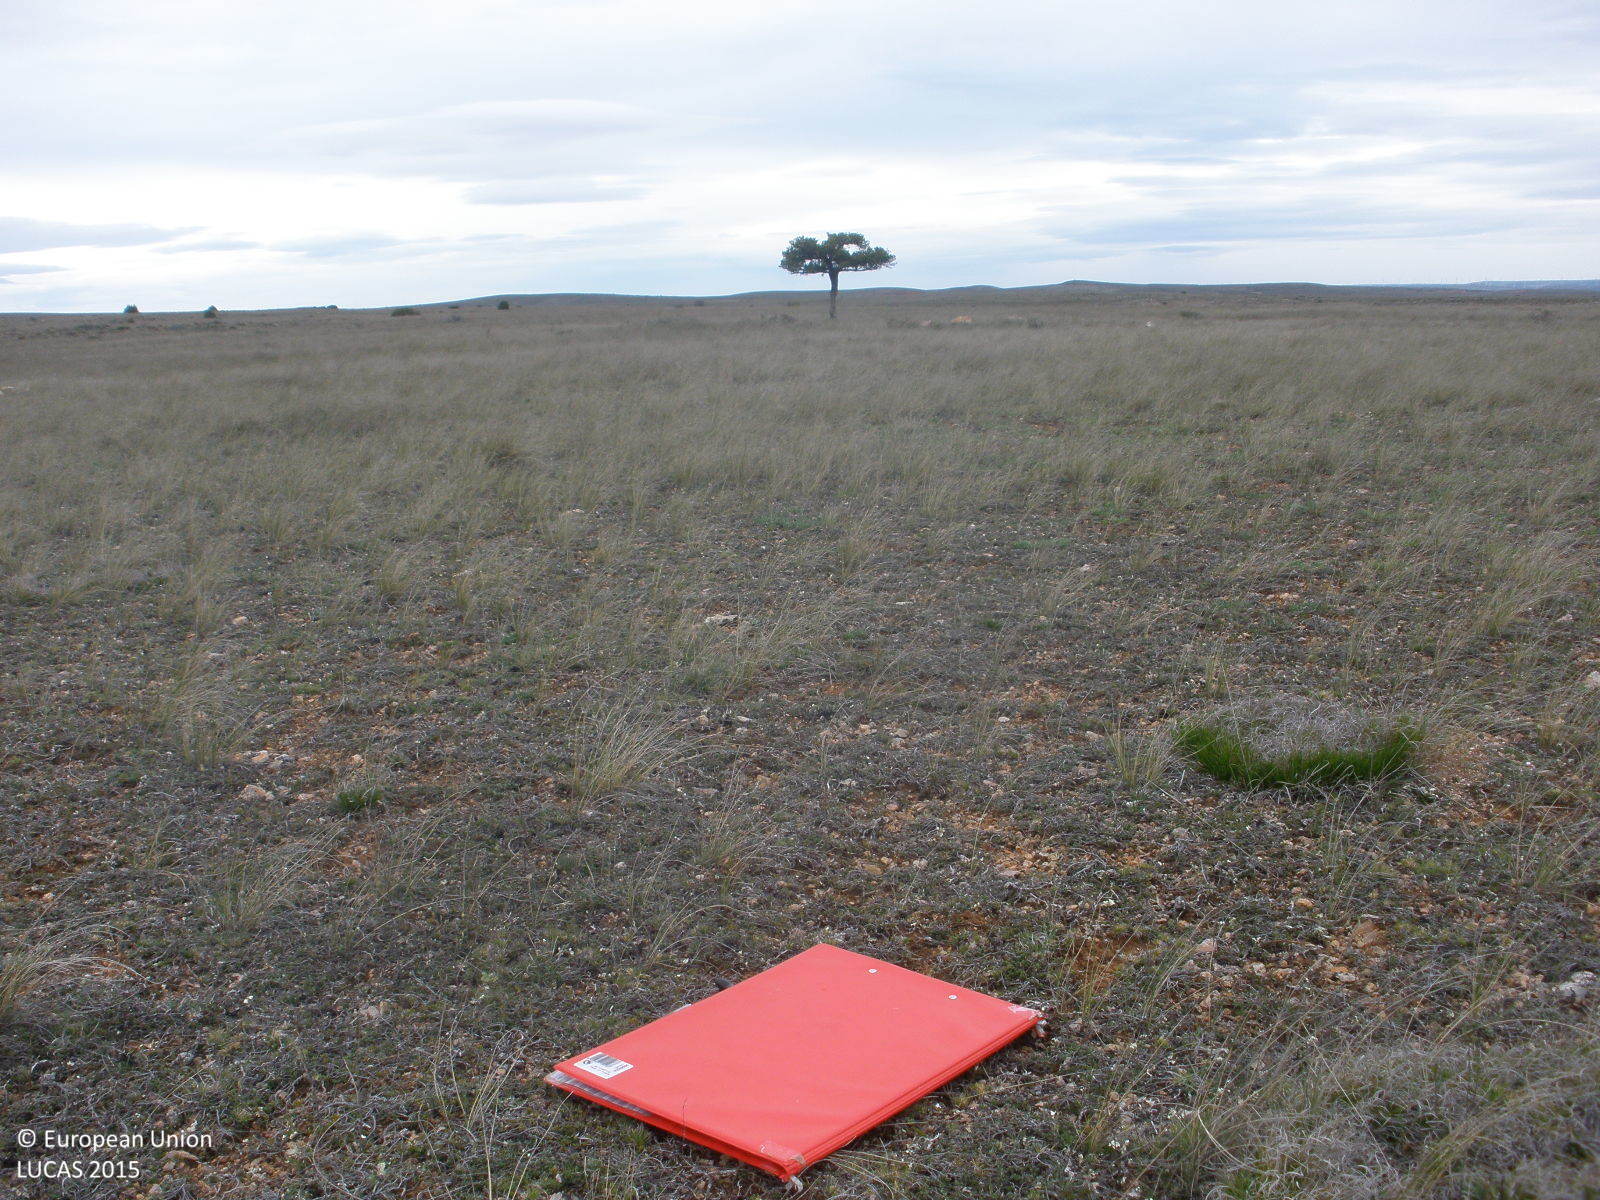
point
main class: Grassland
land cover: Grassland without tree/shrub cover
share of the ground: > 75 %
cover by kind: herbaceous plants 90 %, consolidated bare surface 10 %
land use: Semi-natural and natural areas not in use
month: May
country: ES
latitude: 40.5558
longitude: -0.8641
